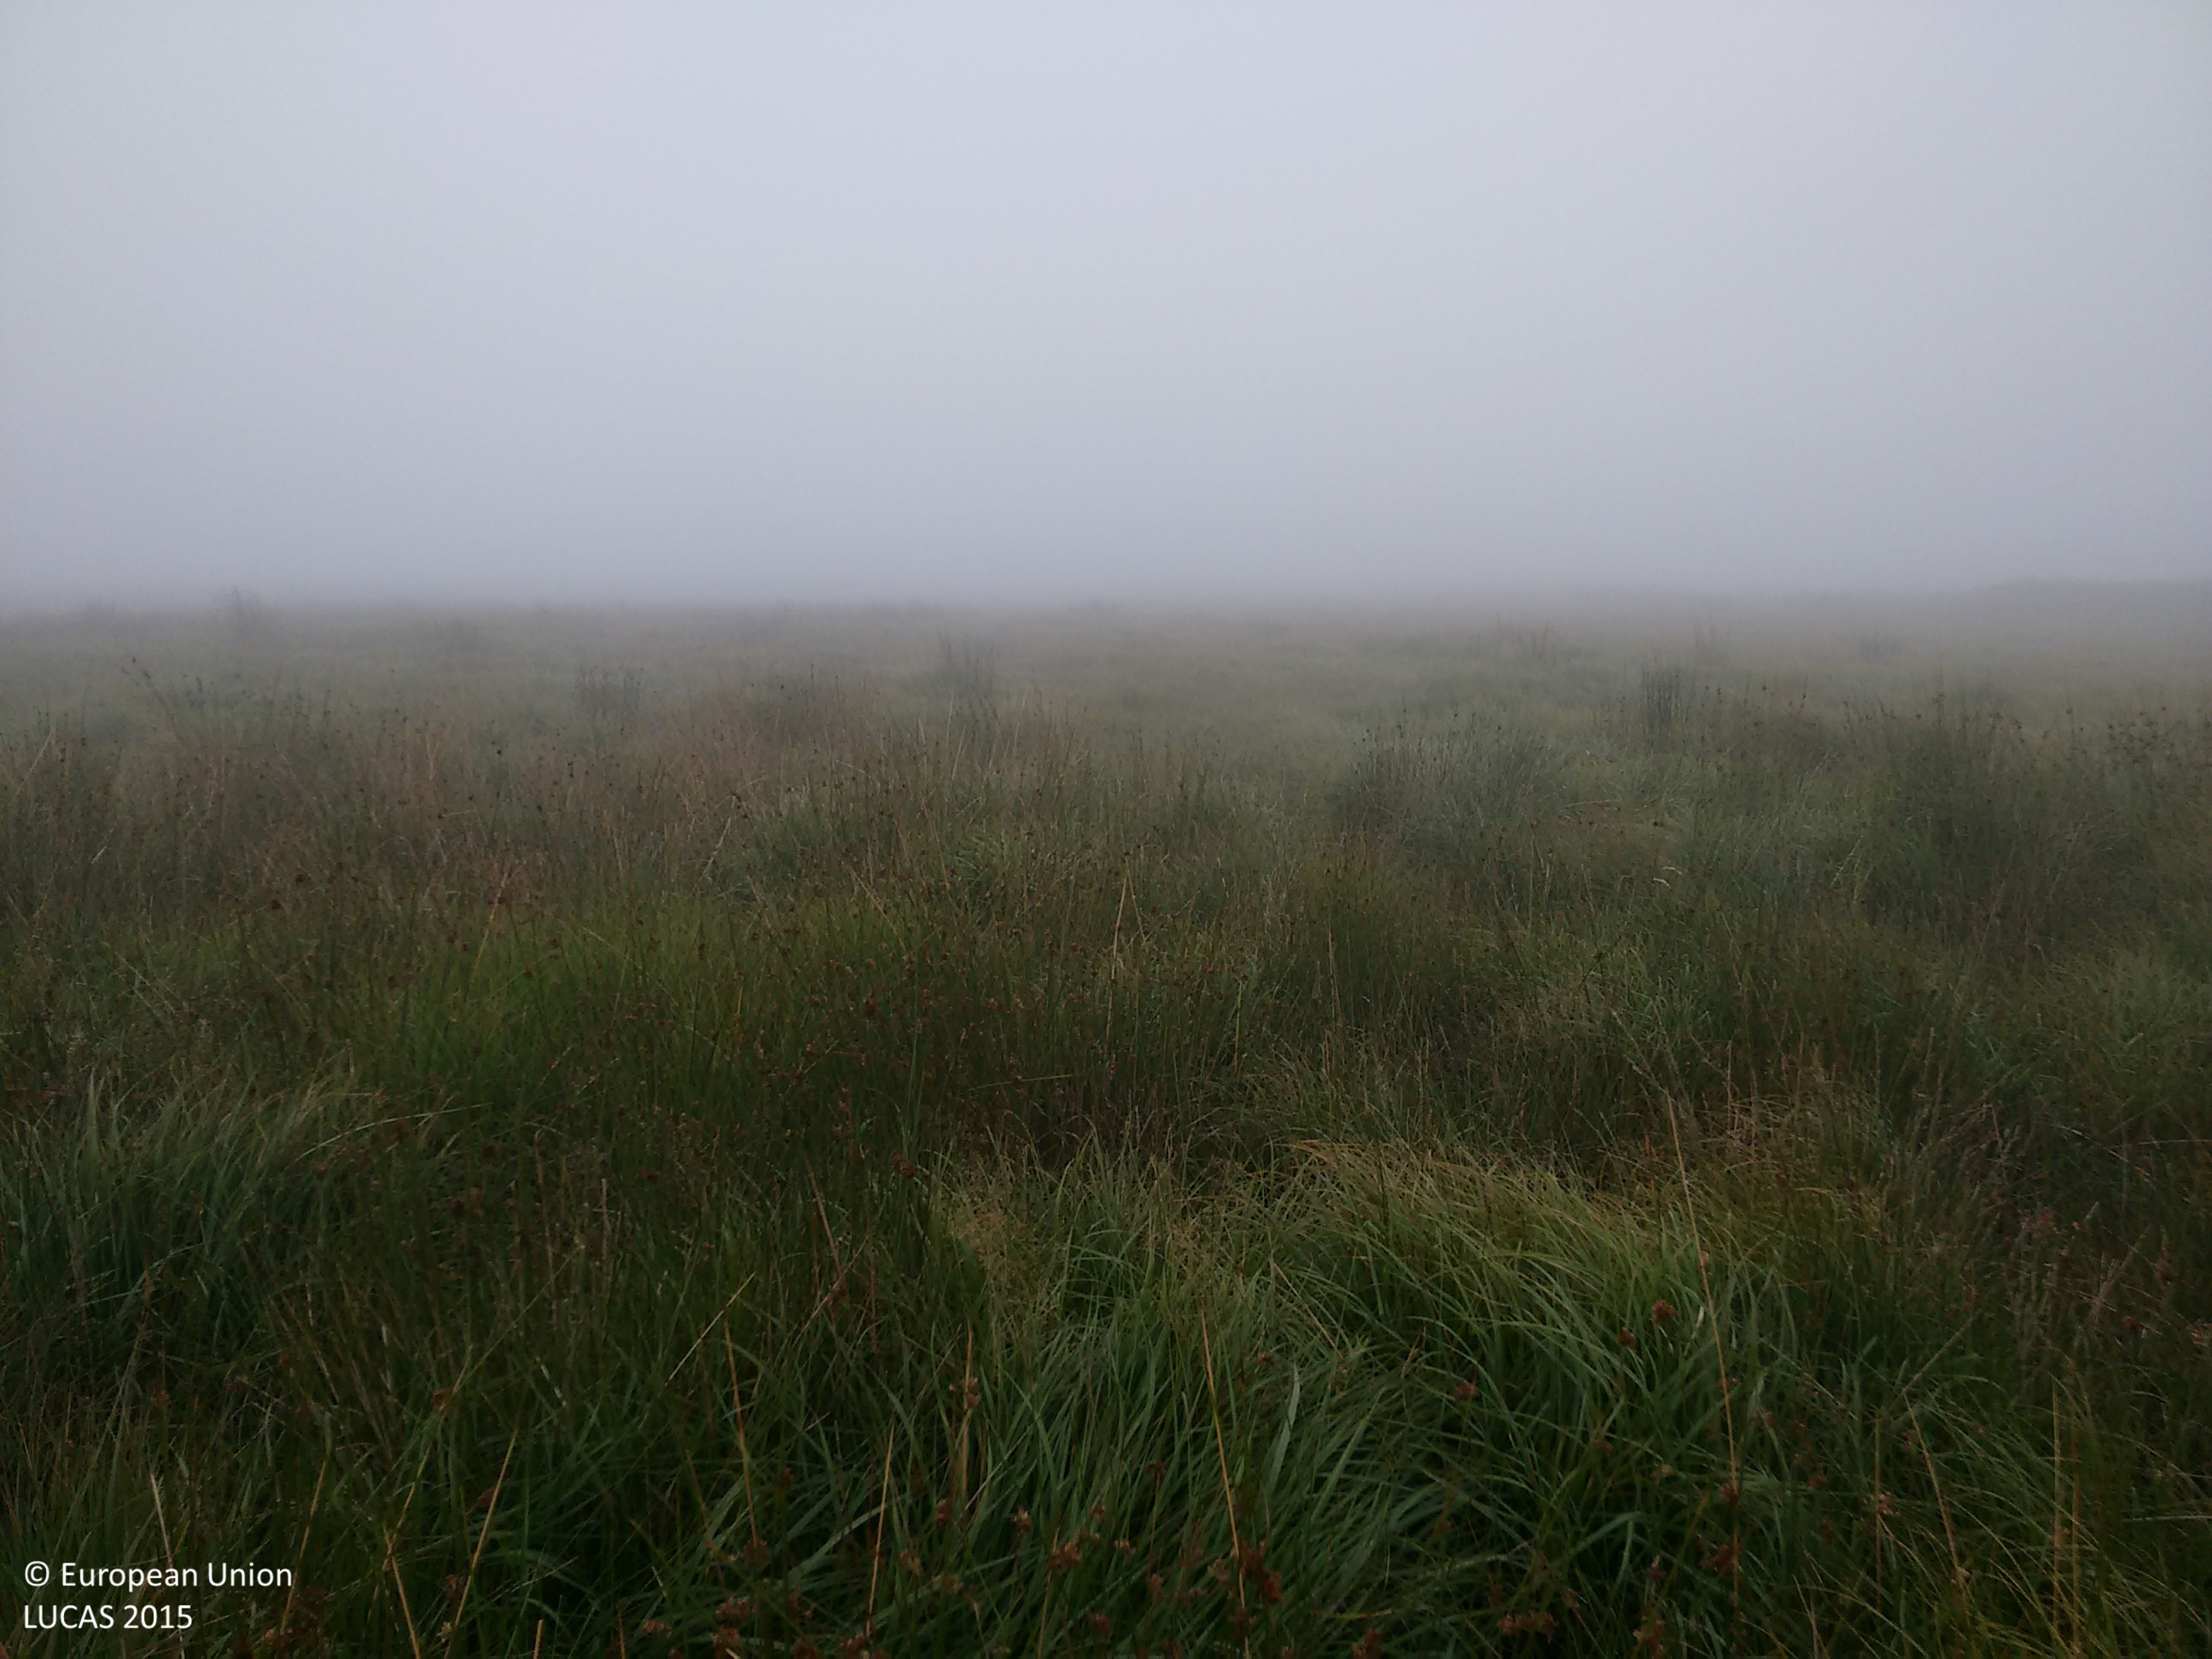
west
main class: Grassland
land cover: Grassland without tree/shrub cover
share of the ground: > 75 %
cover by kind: herbaceous plants 100 %
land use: Agriculture (excluding fallow land and kitchen gardens)
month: August
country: GB
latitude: 51.1114
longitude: -3.7884
